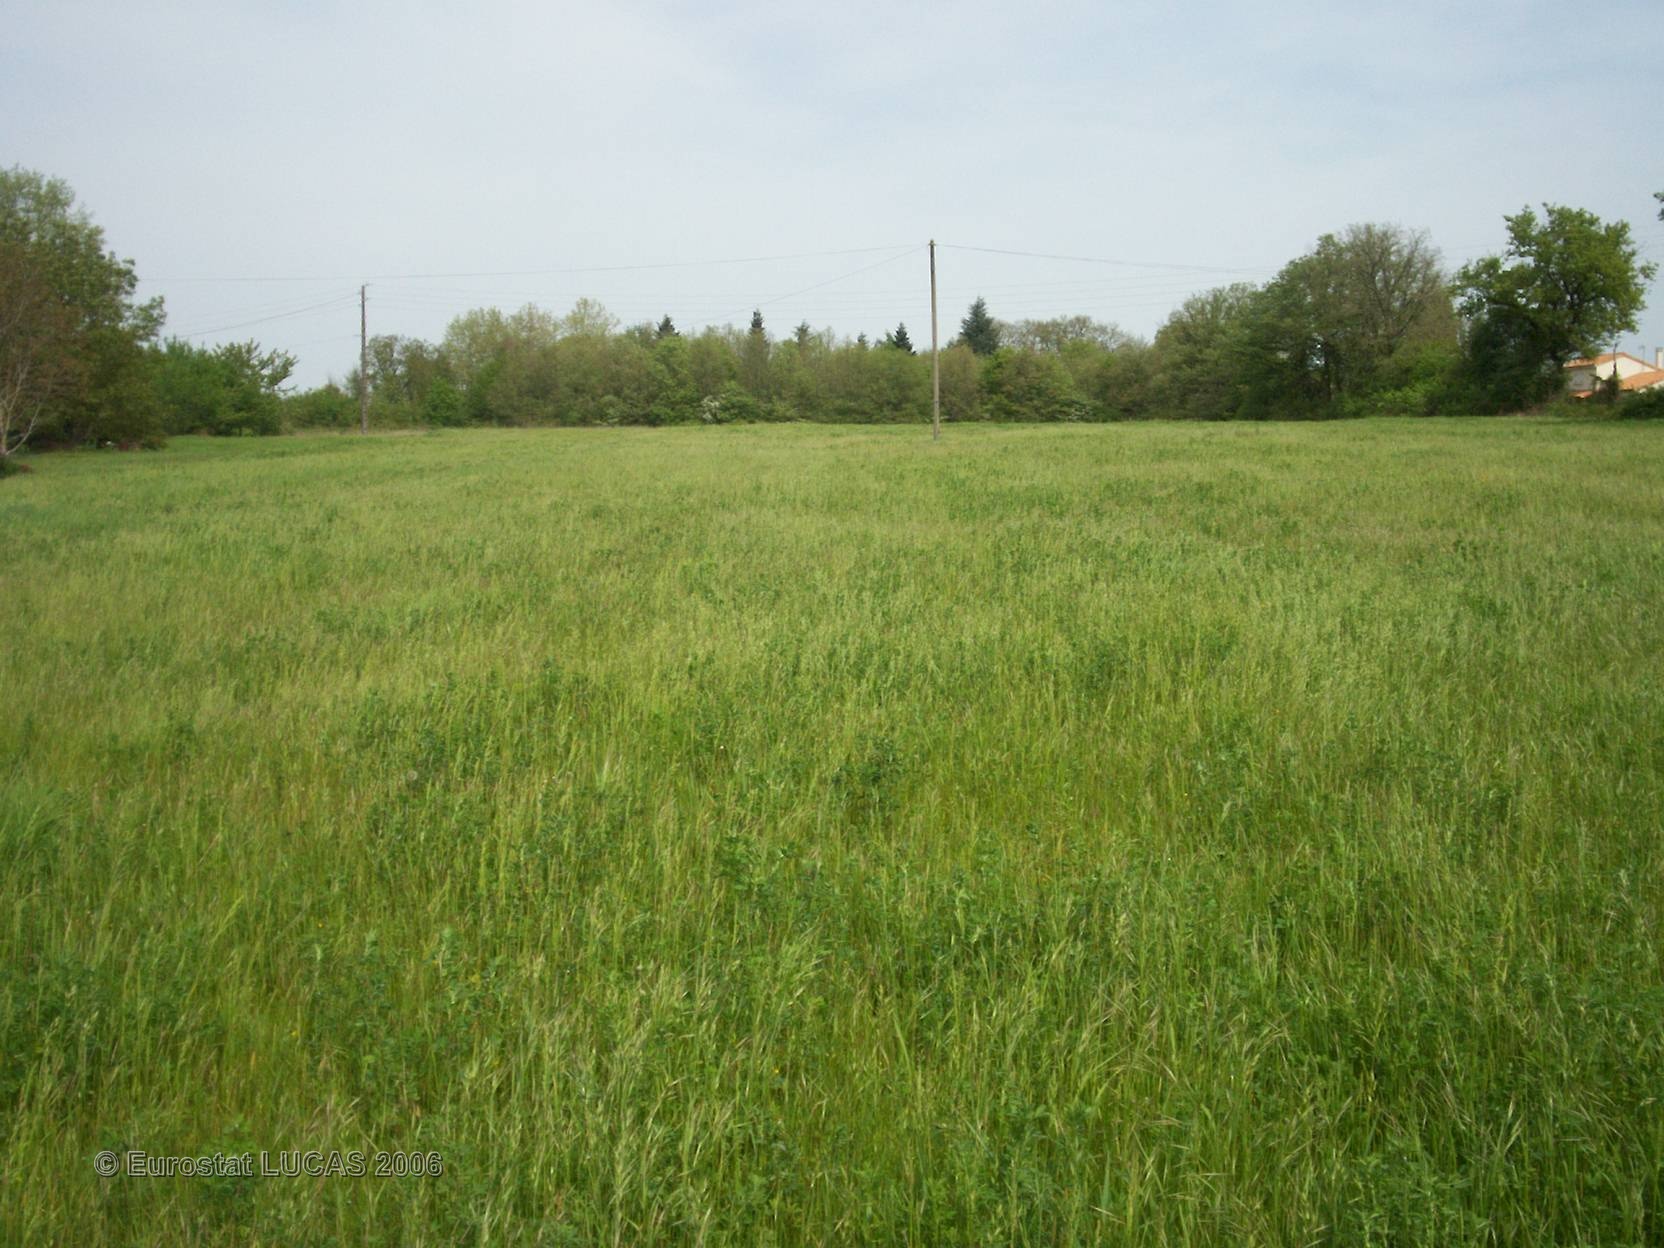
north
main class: Grassland
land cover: Grassland without tree/shrub cover
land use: Agriculture (excluding fallow land and kitchen gardens)
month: May
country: FR
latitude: 46.5596
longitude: 0.4727
